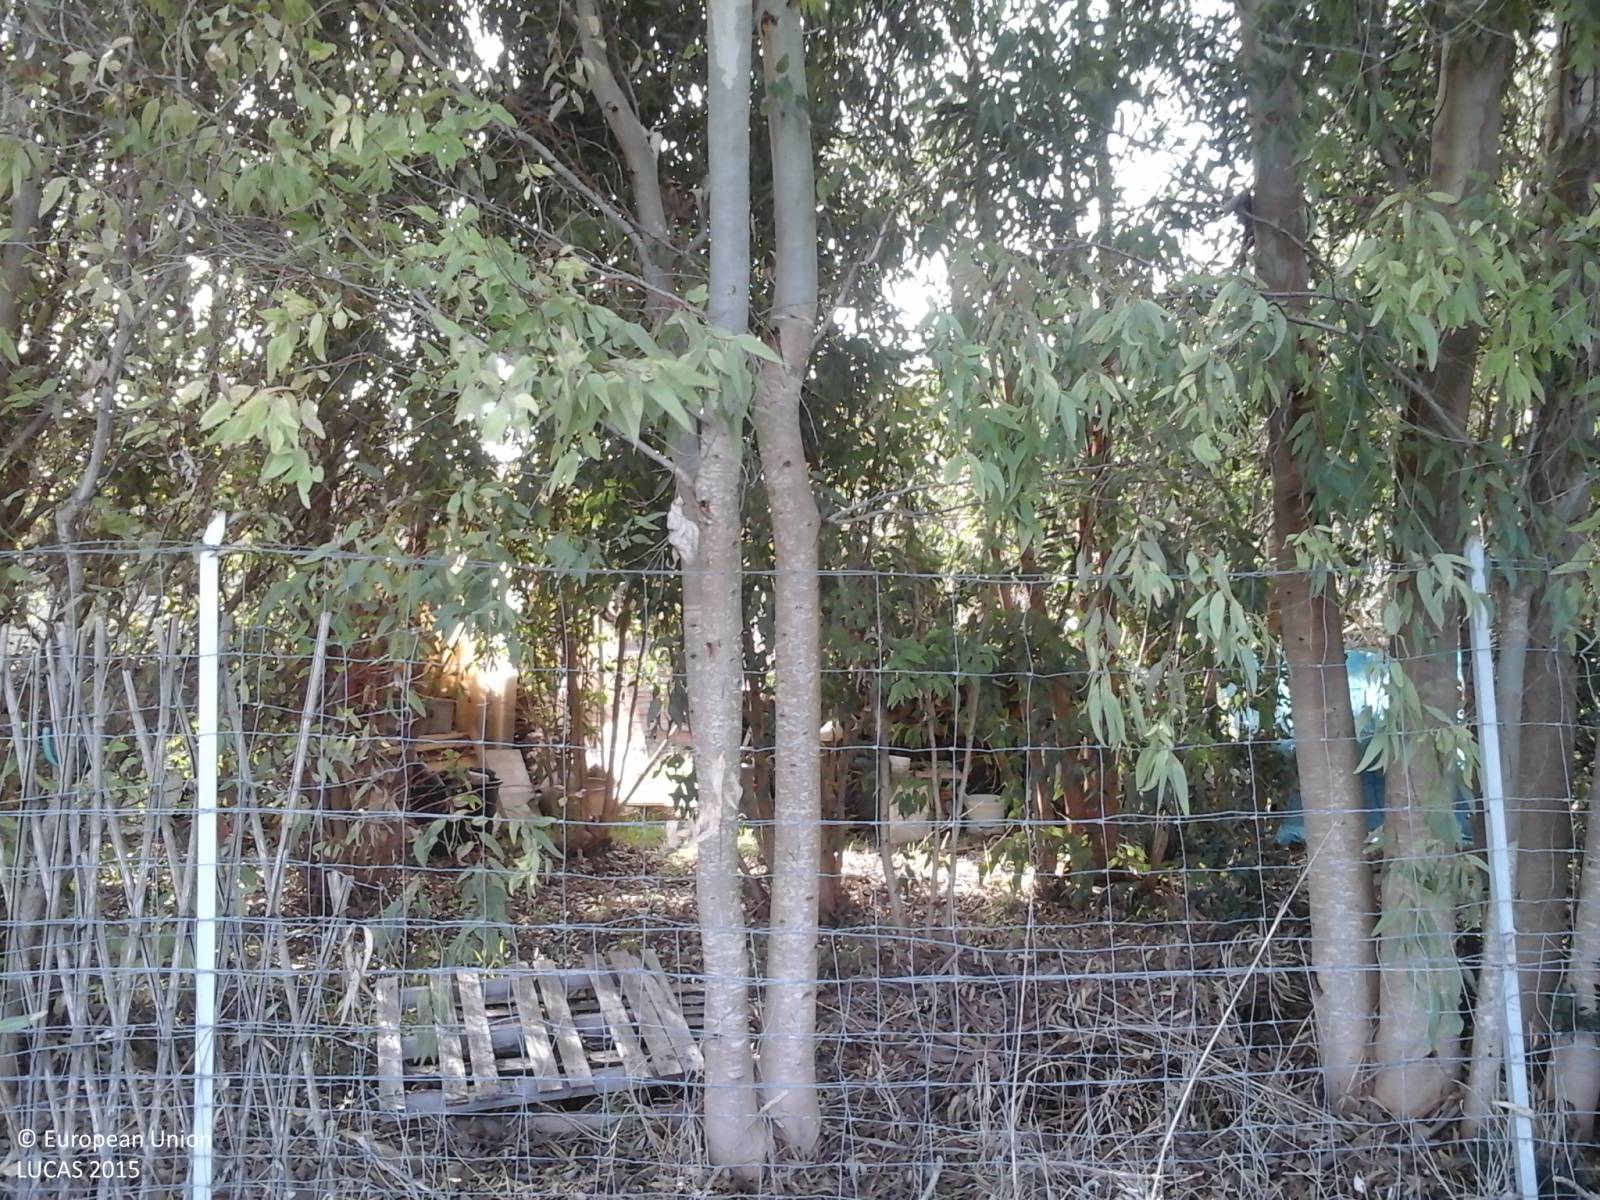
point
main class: Woodland
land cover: Broadleaved woodland
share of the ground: > 75 %
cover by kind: broadleaved forest trees 100 %
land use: Residential
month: January
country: IT
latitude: 39.7328
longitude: 8.6426
